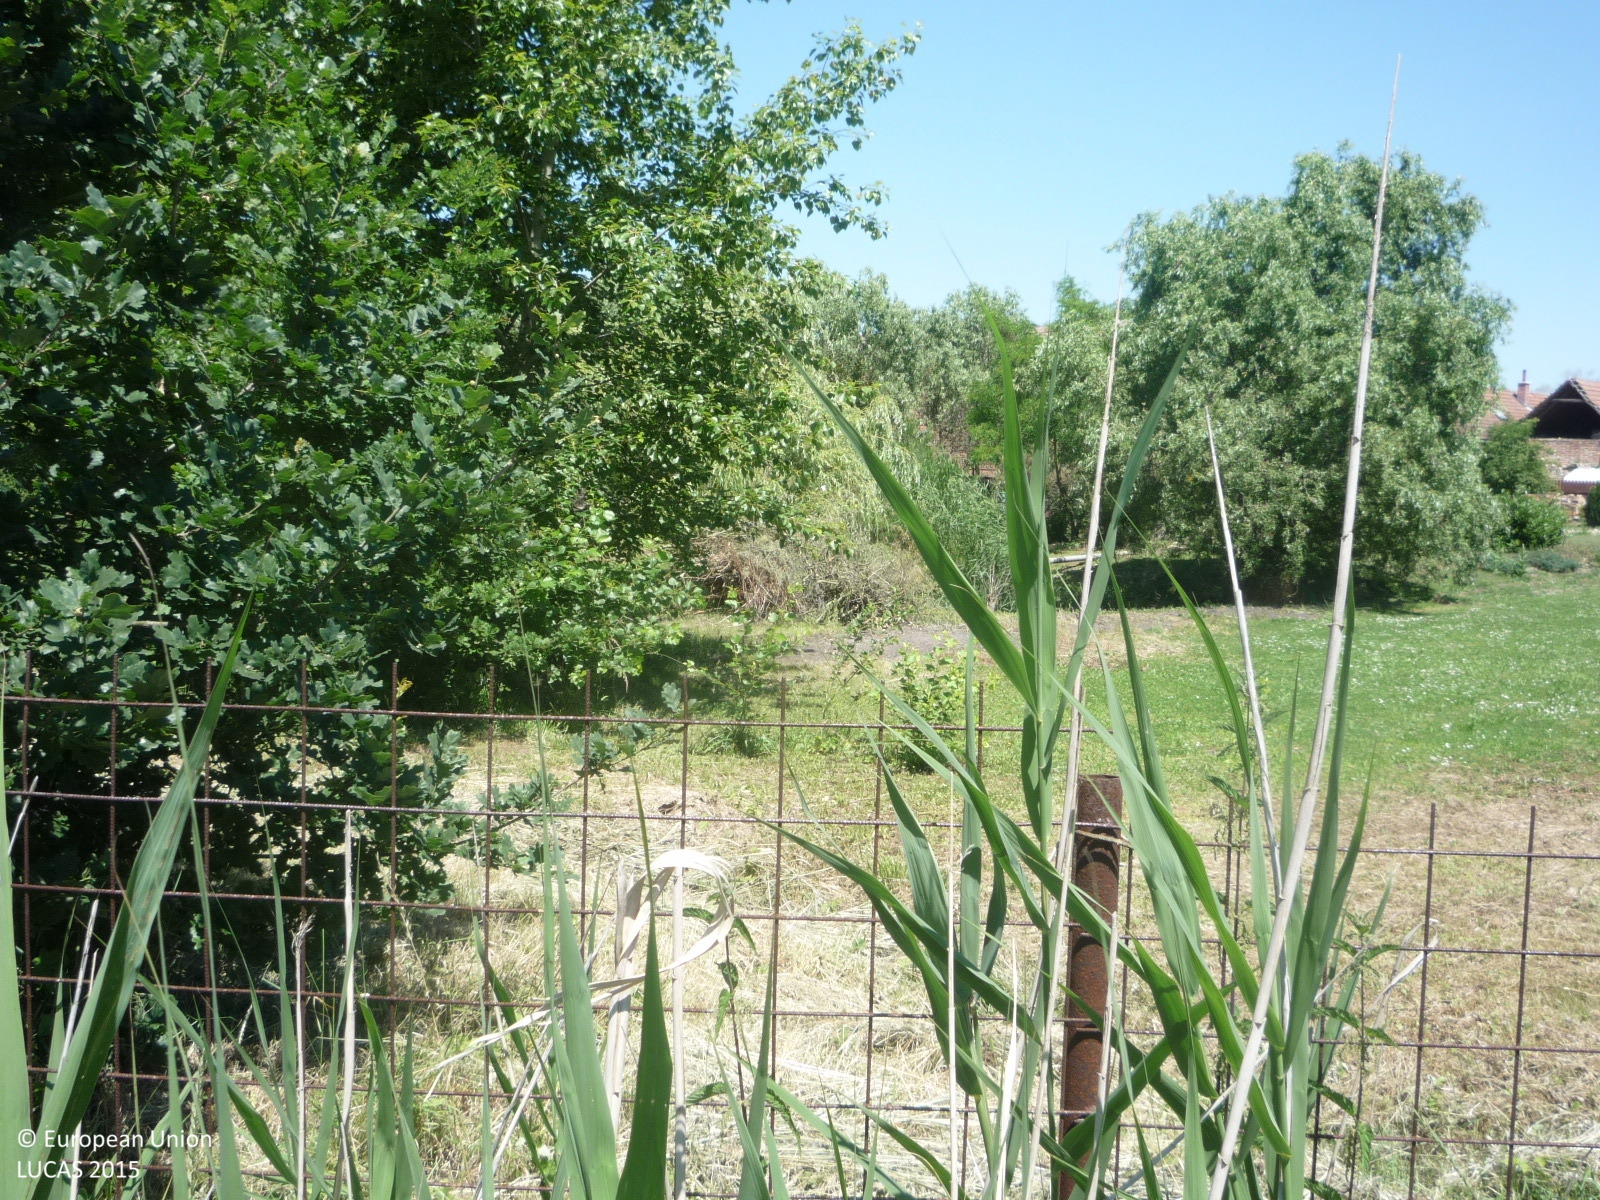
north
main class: Grassland
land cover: Grassland without tree/shrub cover
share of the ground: > 75 %
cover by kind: herbaceous plants 100 %
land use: Amenities, museums, leisure
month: July
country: CZ
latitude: 50.2648
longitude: 15.1798
